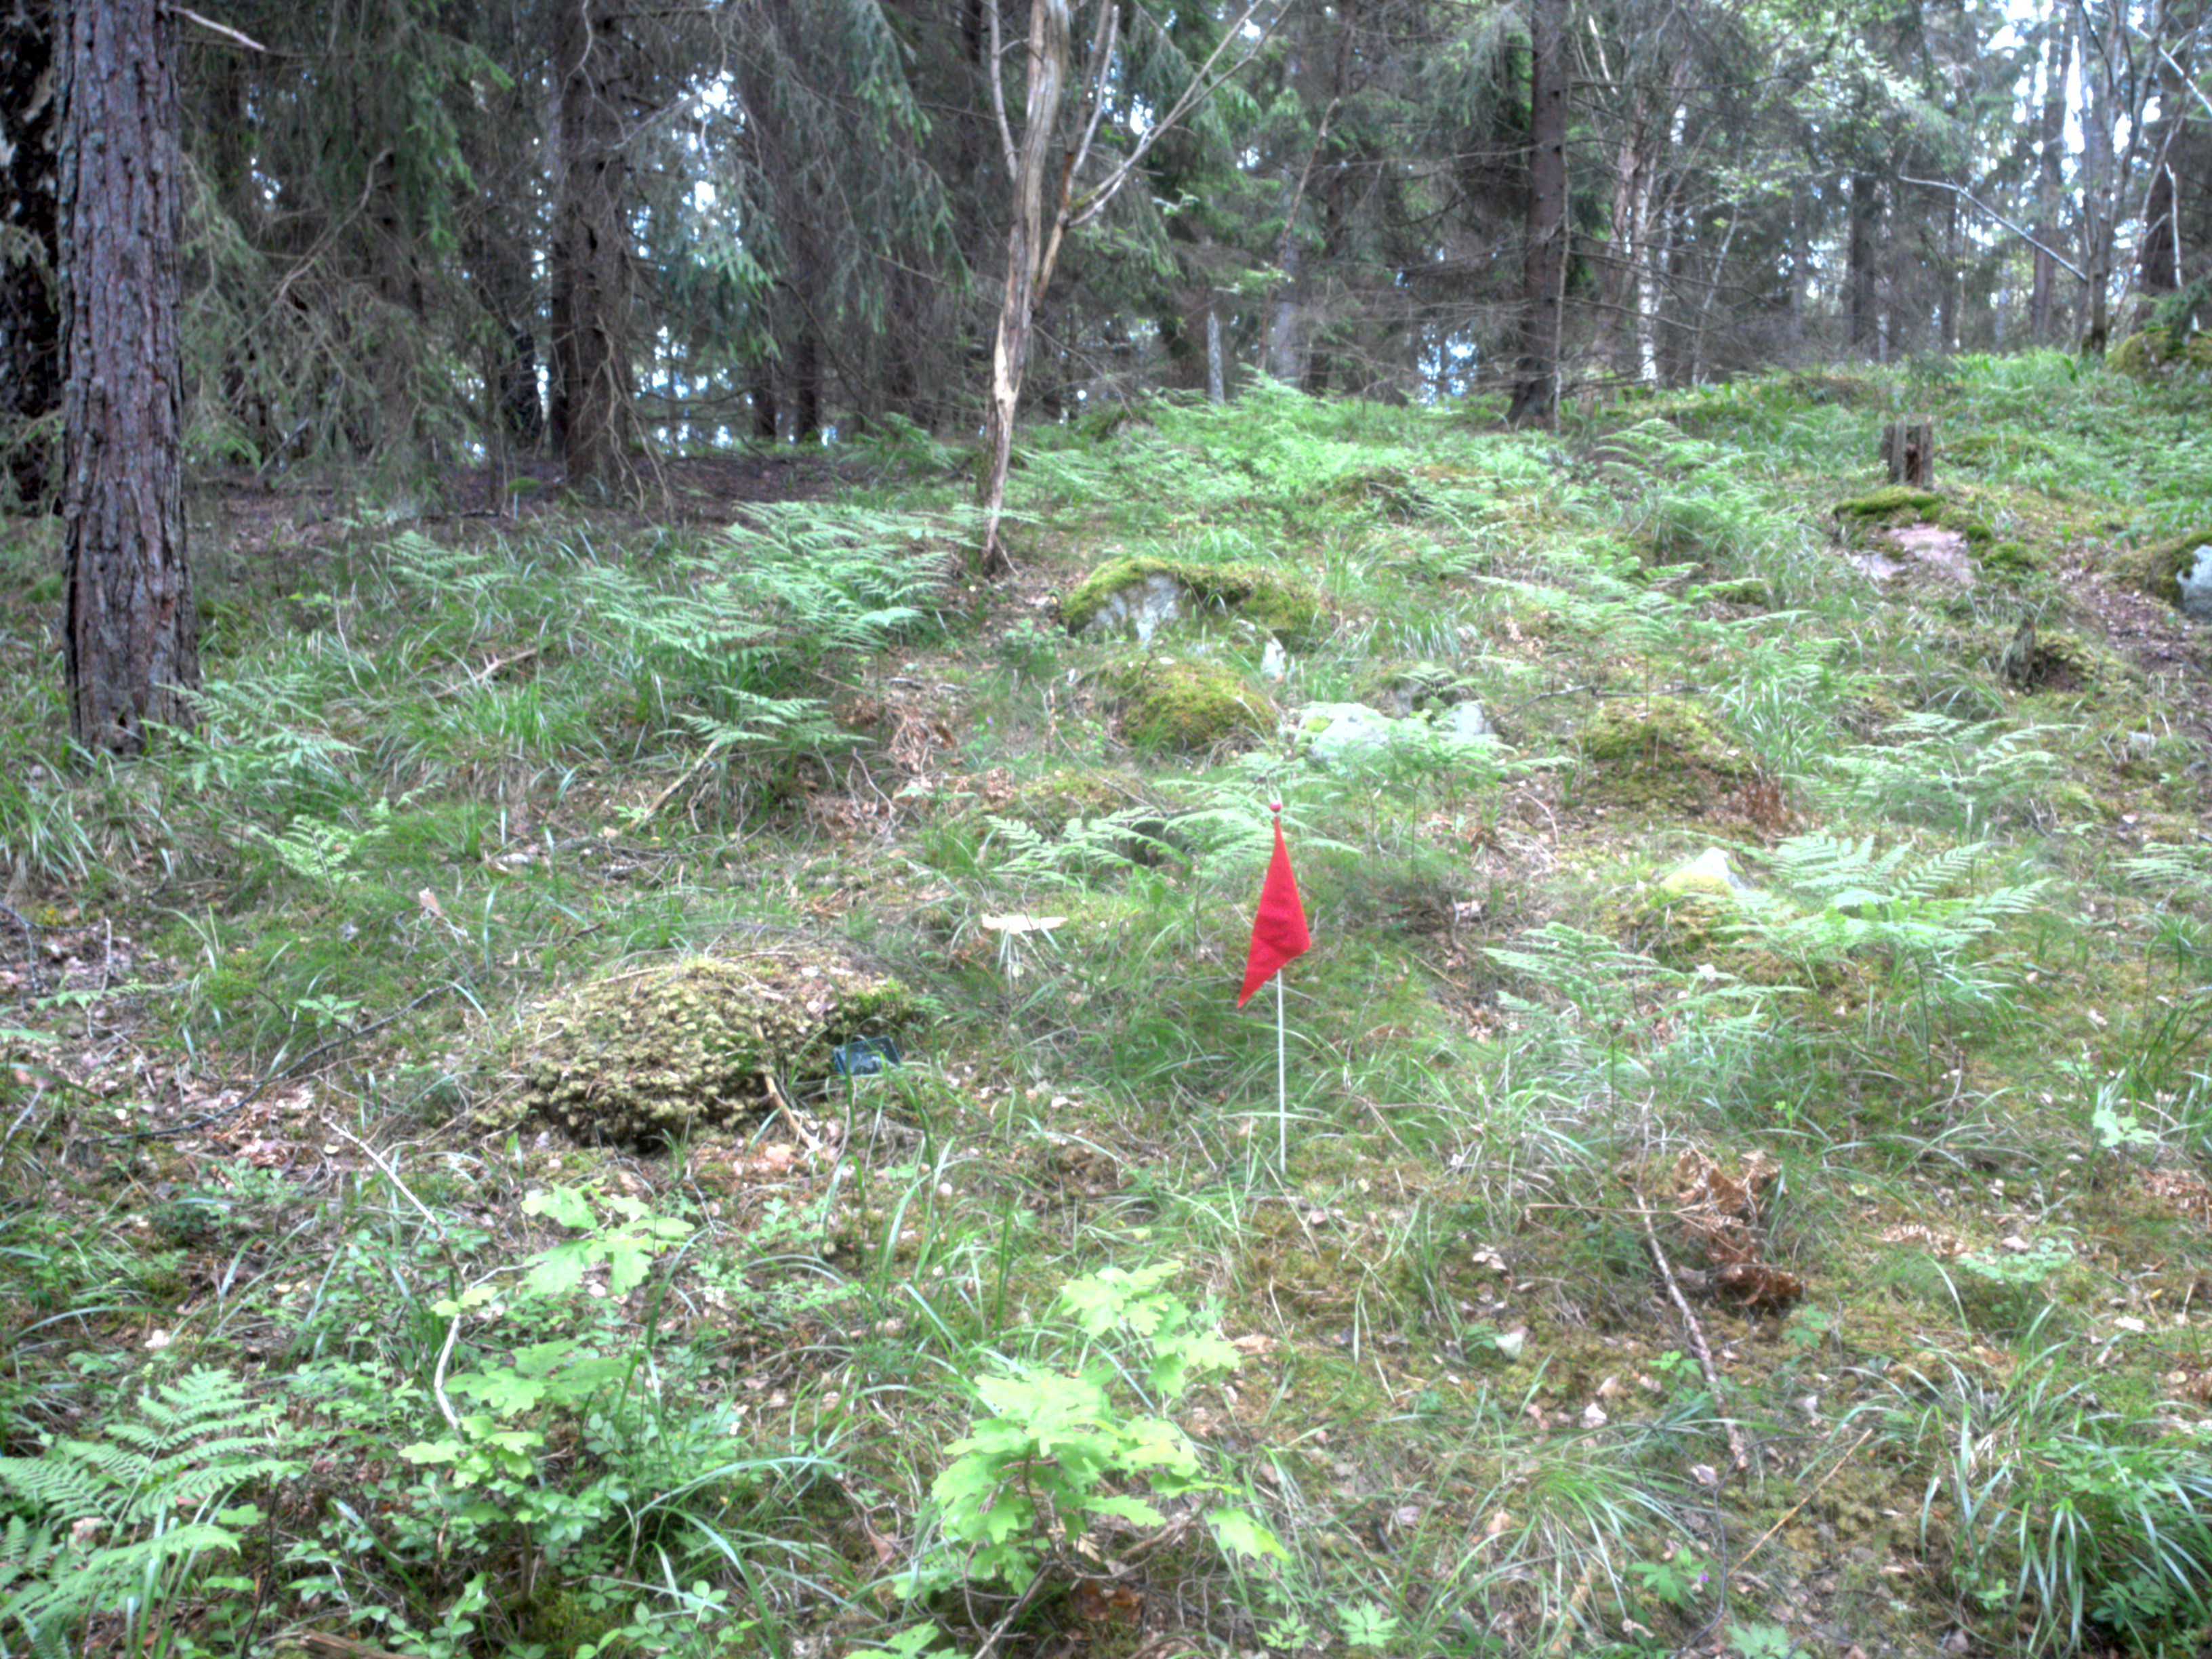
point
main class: Woodland
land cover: Spruce dominated mixed woodland
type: boreal forest
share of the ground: 50 - 75 %
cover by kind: coniferous forest trees 50 %, broadleaved forest trees 20 %, lichens and mosses 20 %, herbaceous plants 10 %
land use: Forestry
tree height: > 5 m
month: June
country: SE
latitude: 59.4215
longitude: 17.8042
